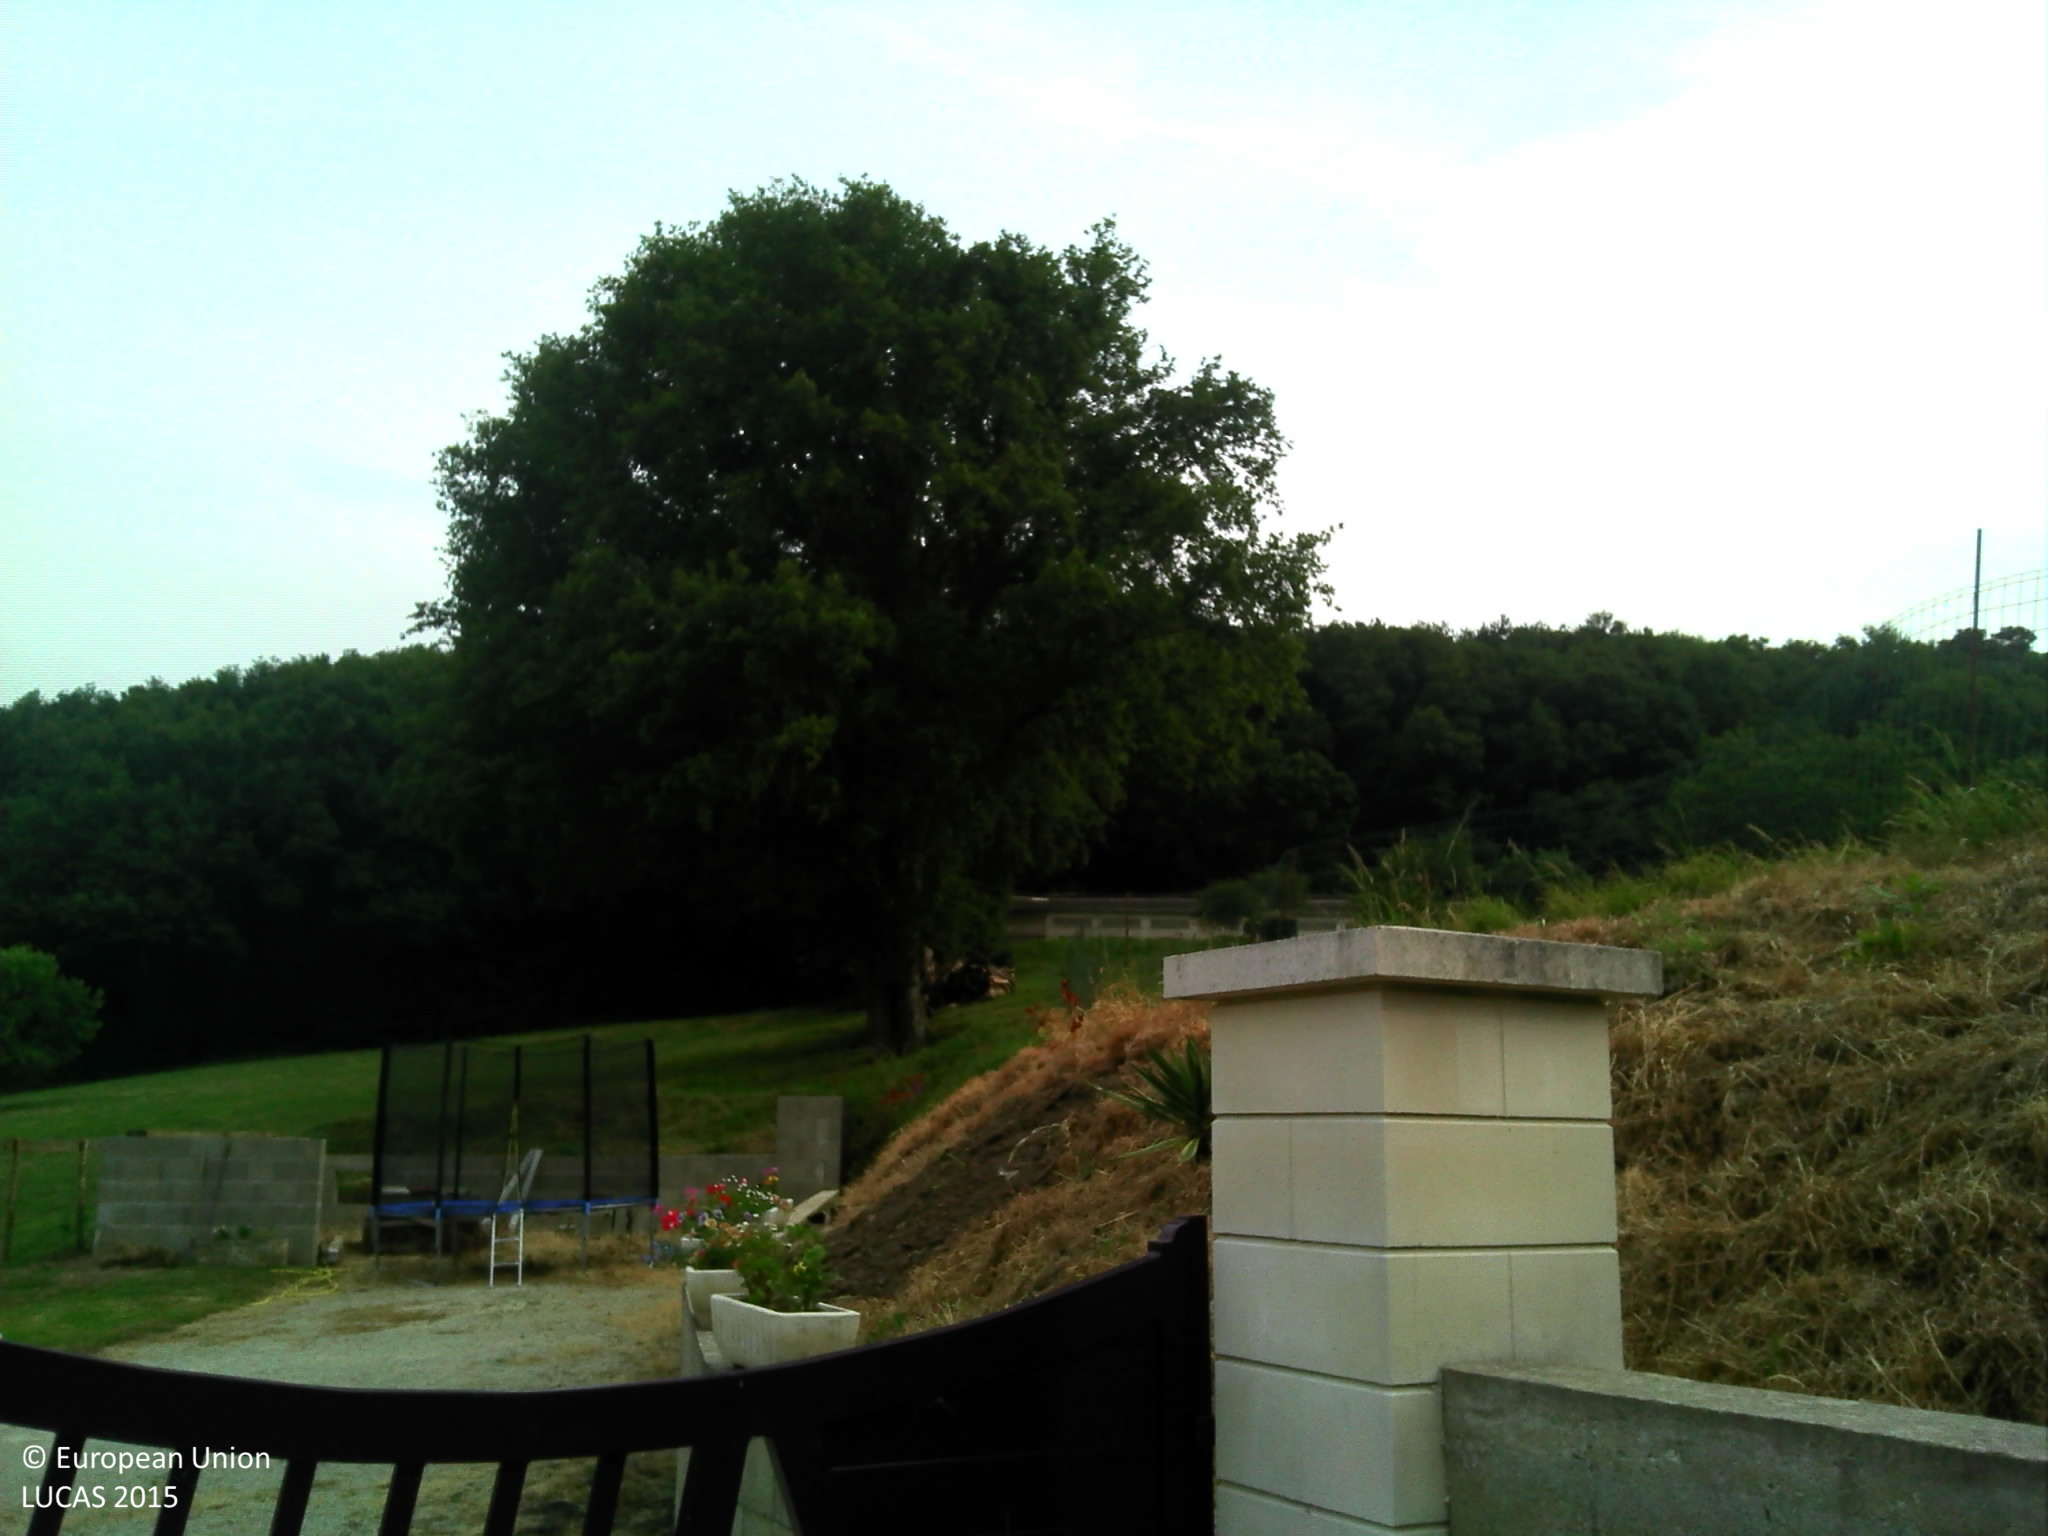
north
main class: Woodland
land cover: Broadleaved woodland
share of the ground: > 75 %
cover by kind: broadleaved forest trees 70 %, herbaceous plants 30 %
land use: Semi-natural and natural areas not in use
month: June
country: FR
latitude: 48.2515
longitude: -0.0631
